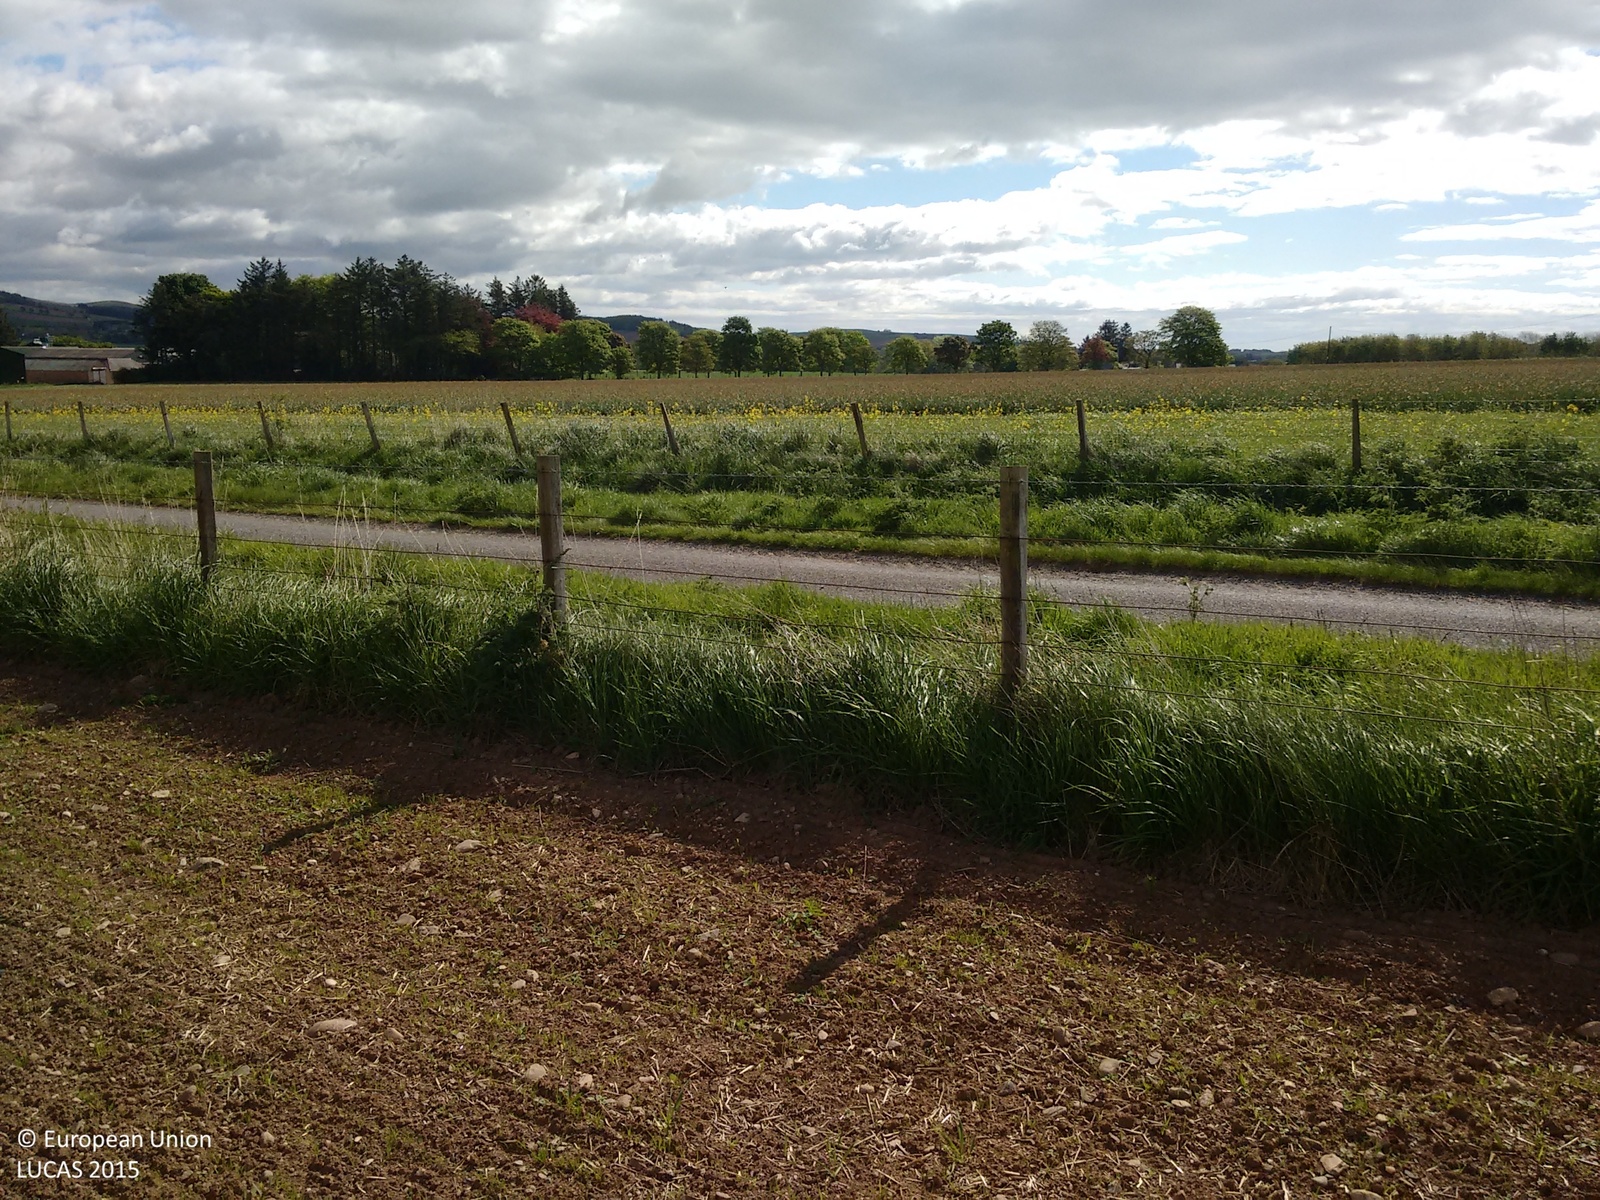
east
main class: Cropland
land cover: Barley
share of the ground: > 75 %
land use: Agriculture (excluding fallow land and kitchen gardens)
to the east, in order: Barley; Fences; Grass margins; Ditches and canals; Grass margins; Paved roads, cycling and walking lanes; Spontaneously vegetated surfaces; Ditches and canals; Grass margins; Fences; Grass margins; Spontaneously vegetated surfaces; Floriculture and ornamental plants; Grass margins; Fences; Lines of trees; Fences; Grassland without tree/shrub cover
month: May
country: GB
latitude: 56.7722
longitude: -2.5416
